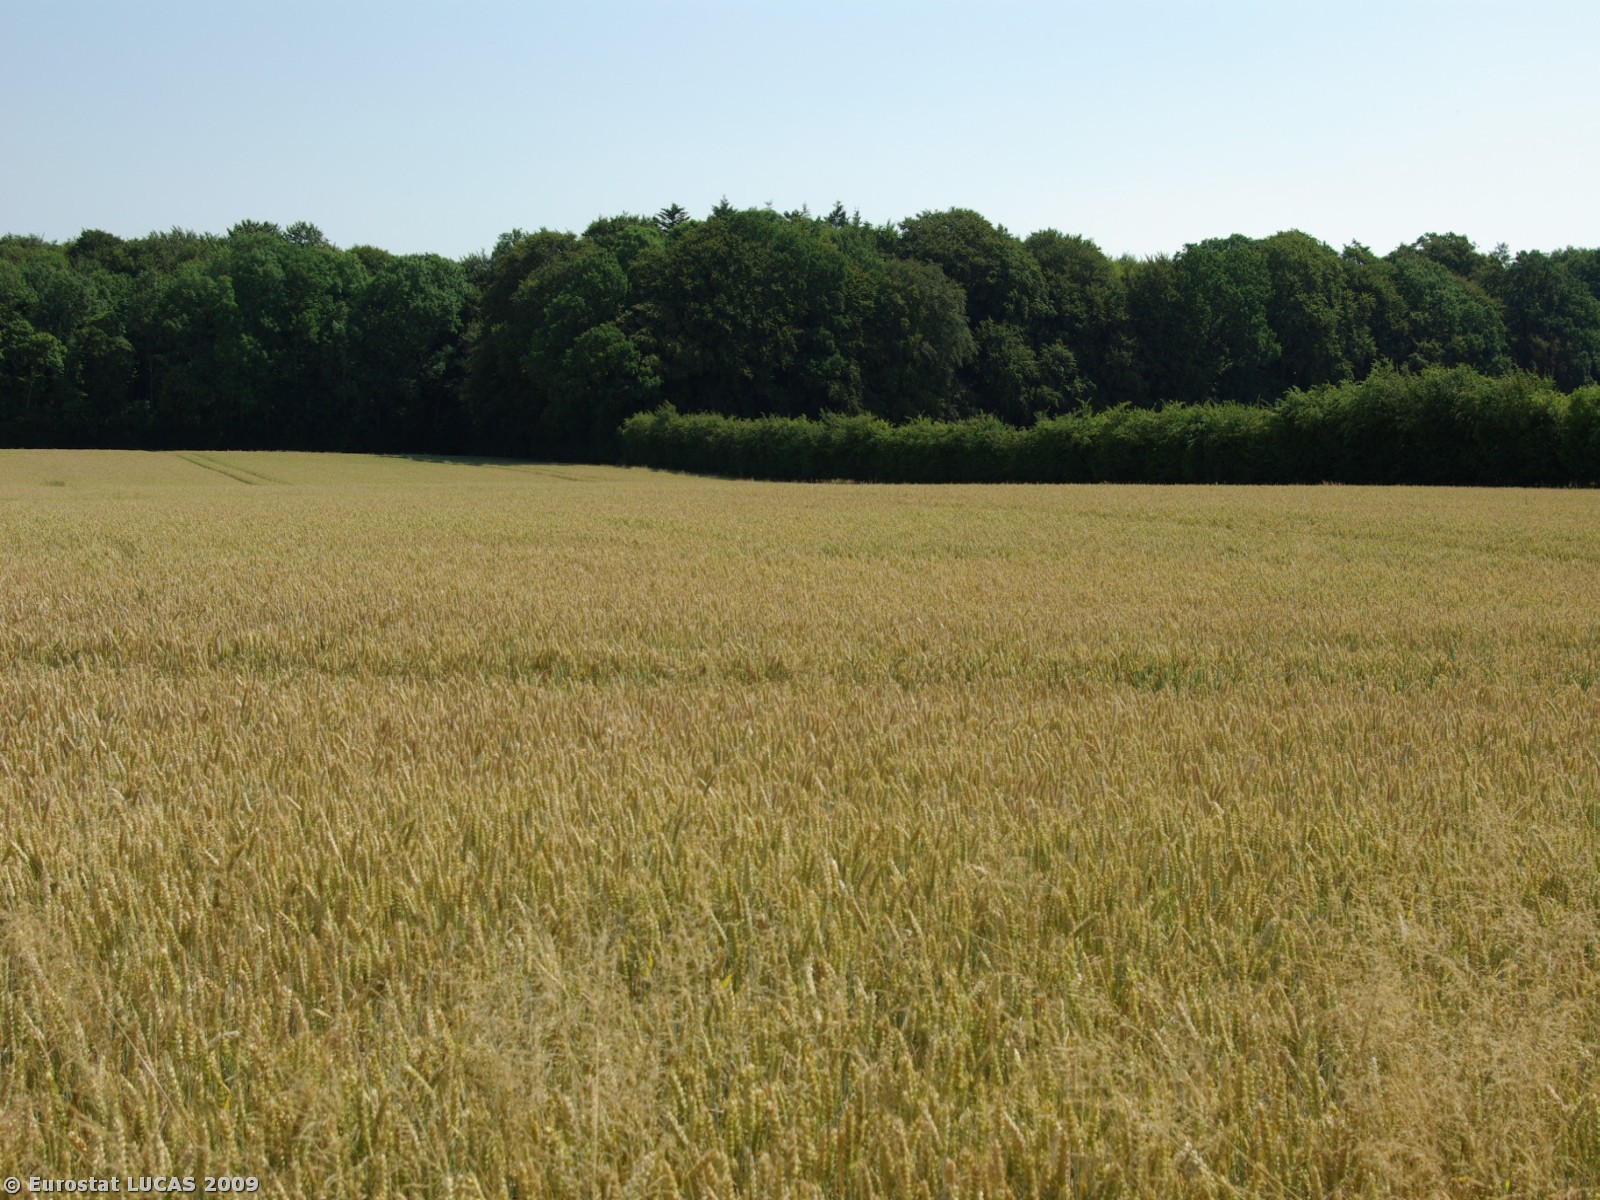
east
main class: Cropland
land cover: Common wheat
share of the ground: > 75 %
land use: Agriculture (excluding fallow land and kitchen gardens)
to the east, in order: Common wheat; Broadleaved woodland; Triticale; Broadleaved woodland
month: July
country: DK
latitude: 54.9652
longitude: 9.7347
